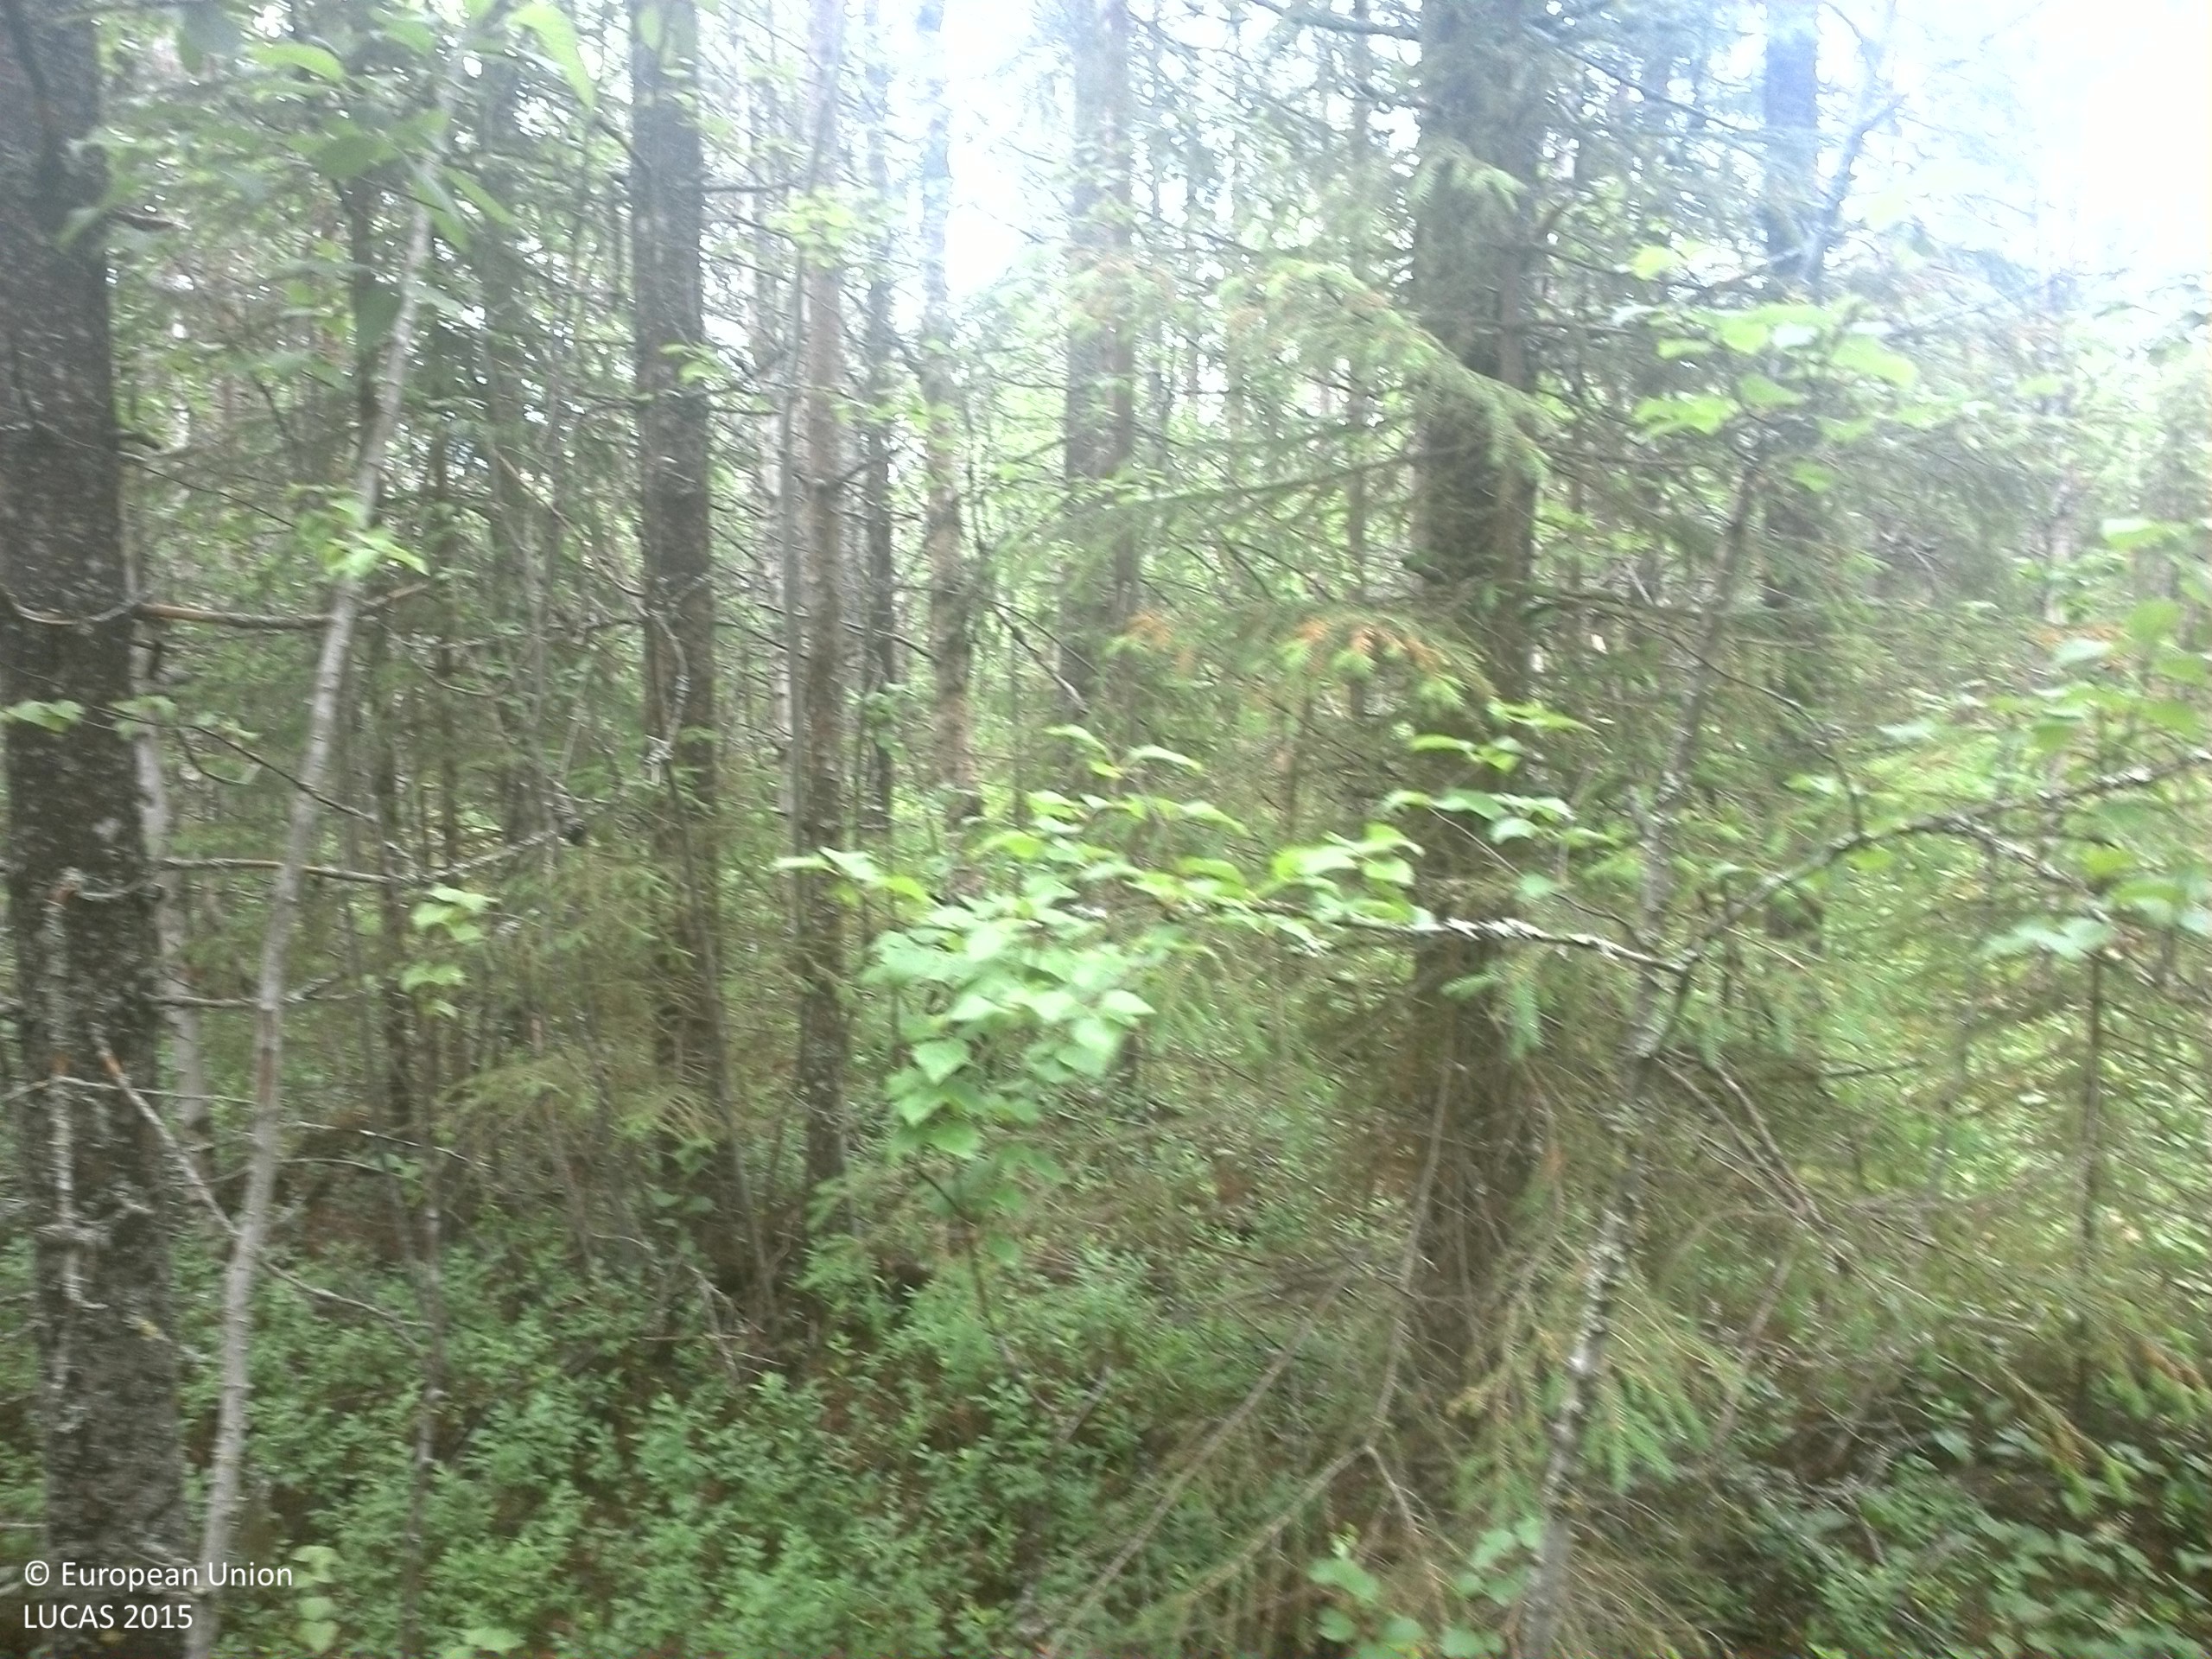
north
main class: Woodland
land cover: Pine dominated mixed woodland
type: exotic forest
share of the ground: > 75 %
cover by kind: coniferous forest trees 60 %, broadleaved forest trees 20 %, shrubs 20 %
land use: Forestry
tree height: > 5 m
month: July
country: SE
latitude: 63.5686
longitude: 18.5334
